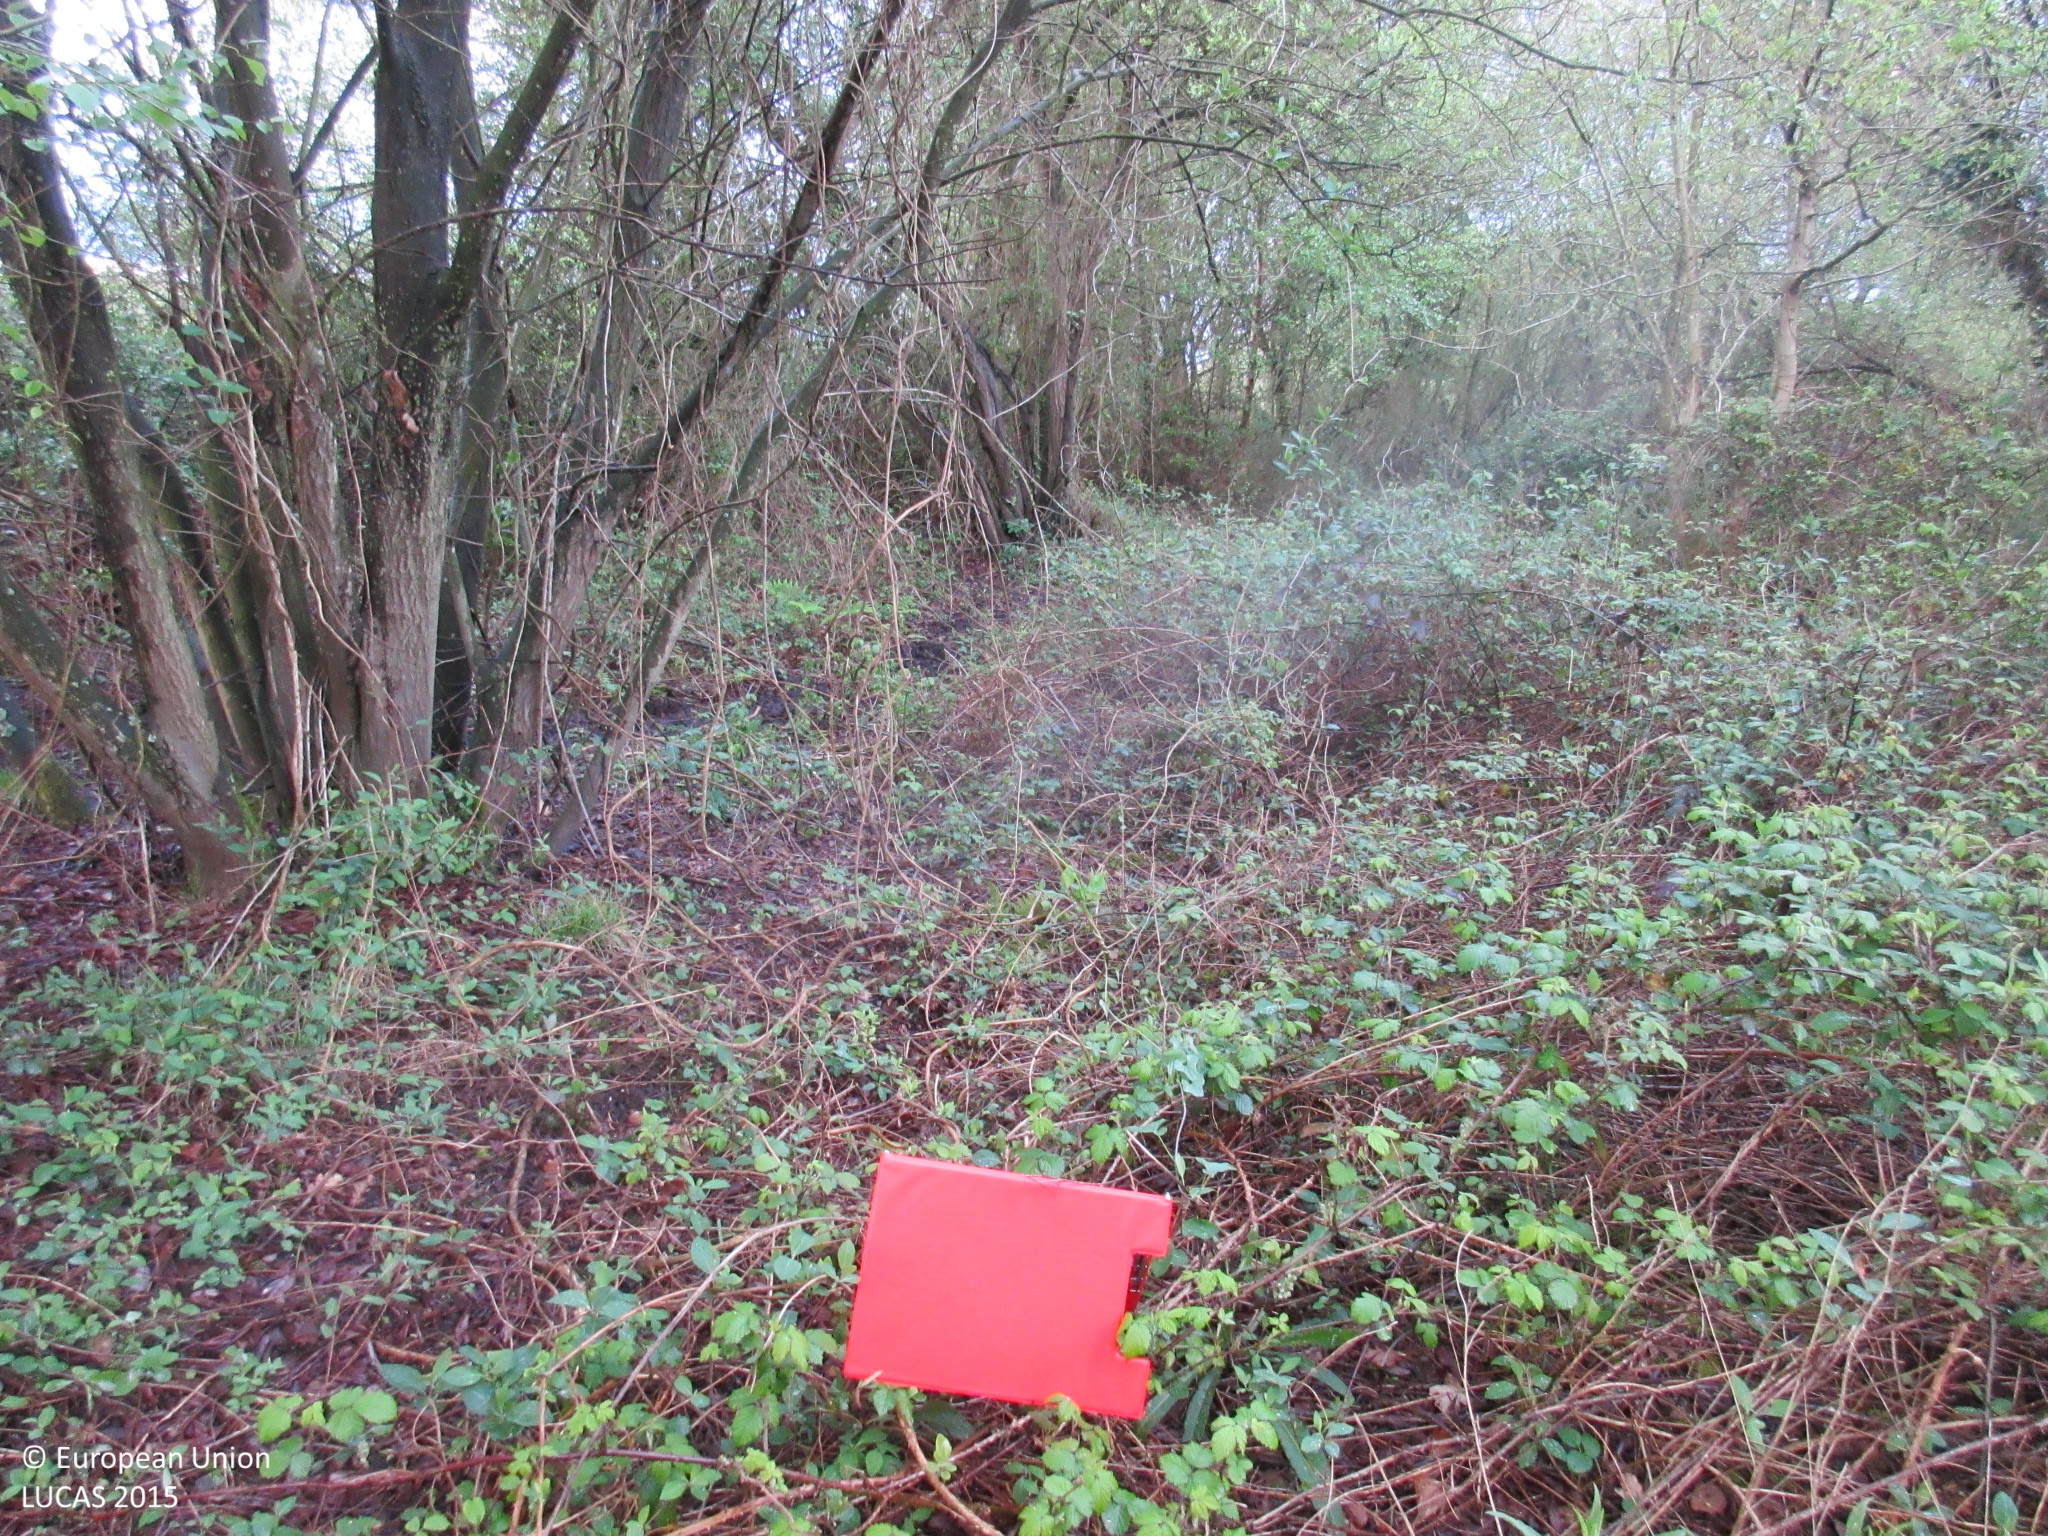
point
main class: Woodland
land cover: Broadleaved woodland
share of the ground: > 75 %
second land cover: Shrubland without tree cover
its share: 10 - 25 %
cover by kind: broadleaved forest trees 80 %, shrubs 10 %, herbaceous plants 10 %
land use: Forestry
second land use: Agriculture (excluding fallow land and kitchen gardens)
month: April
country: ES
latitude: 43.5186
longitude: -5.3067
